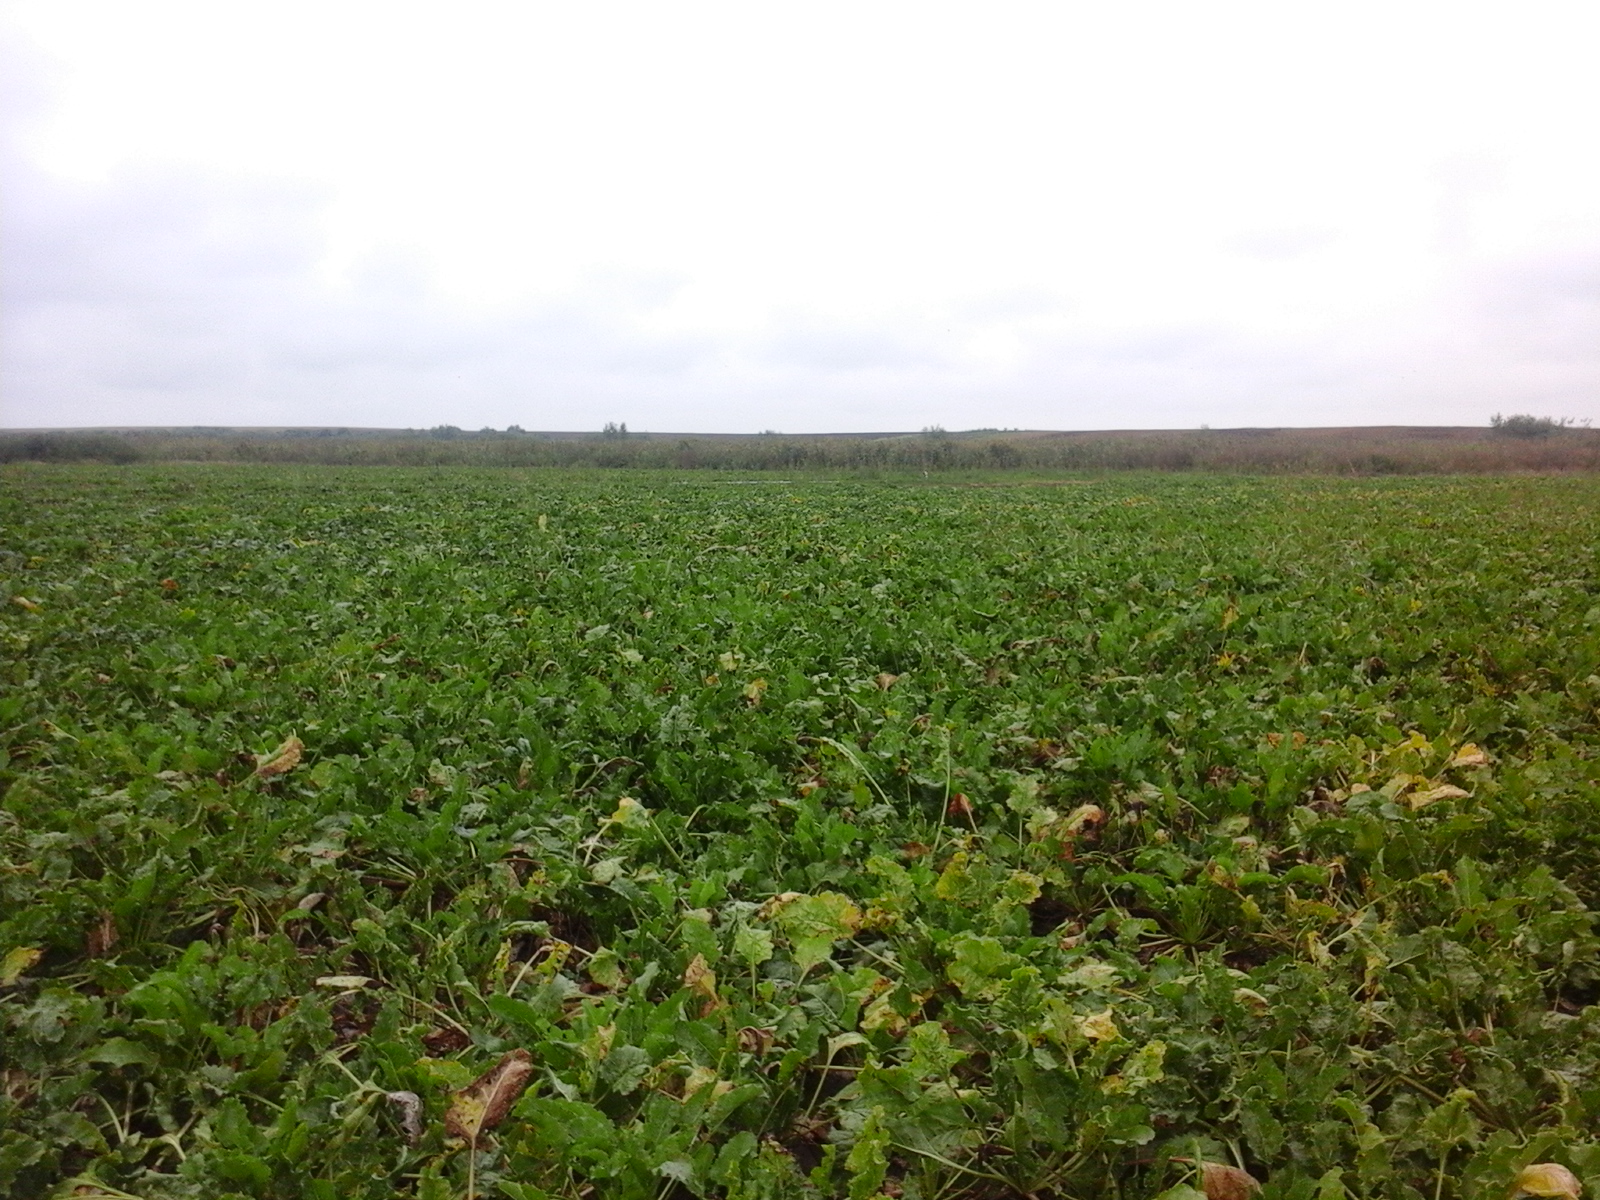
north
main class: Cropland
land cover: Sugar beet
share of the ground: > 75 %
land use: Agriculture (excluding fallow land and kitchen gardens)
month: September
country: RO
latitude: 47.1604
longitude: 21.8781
